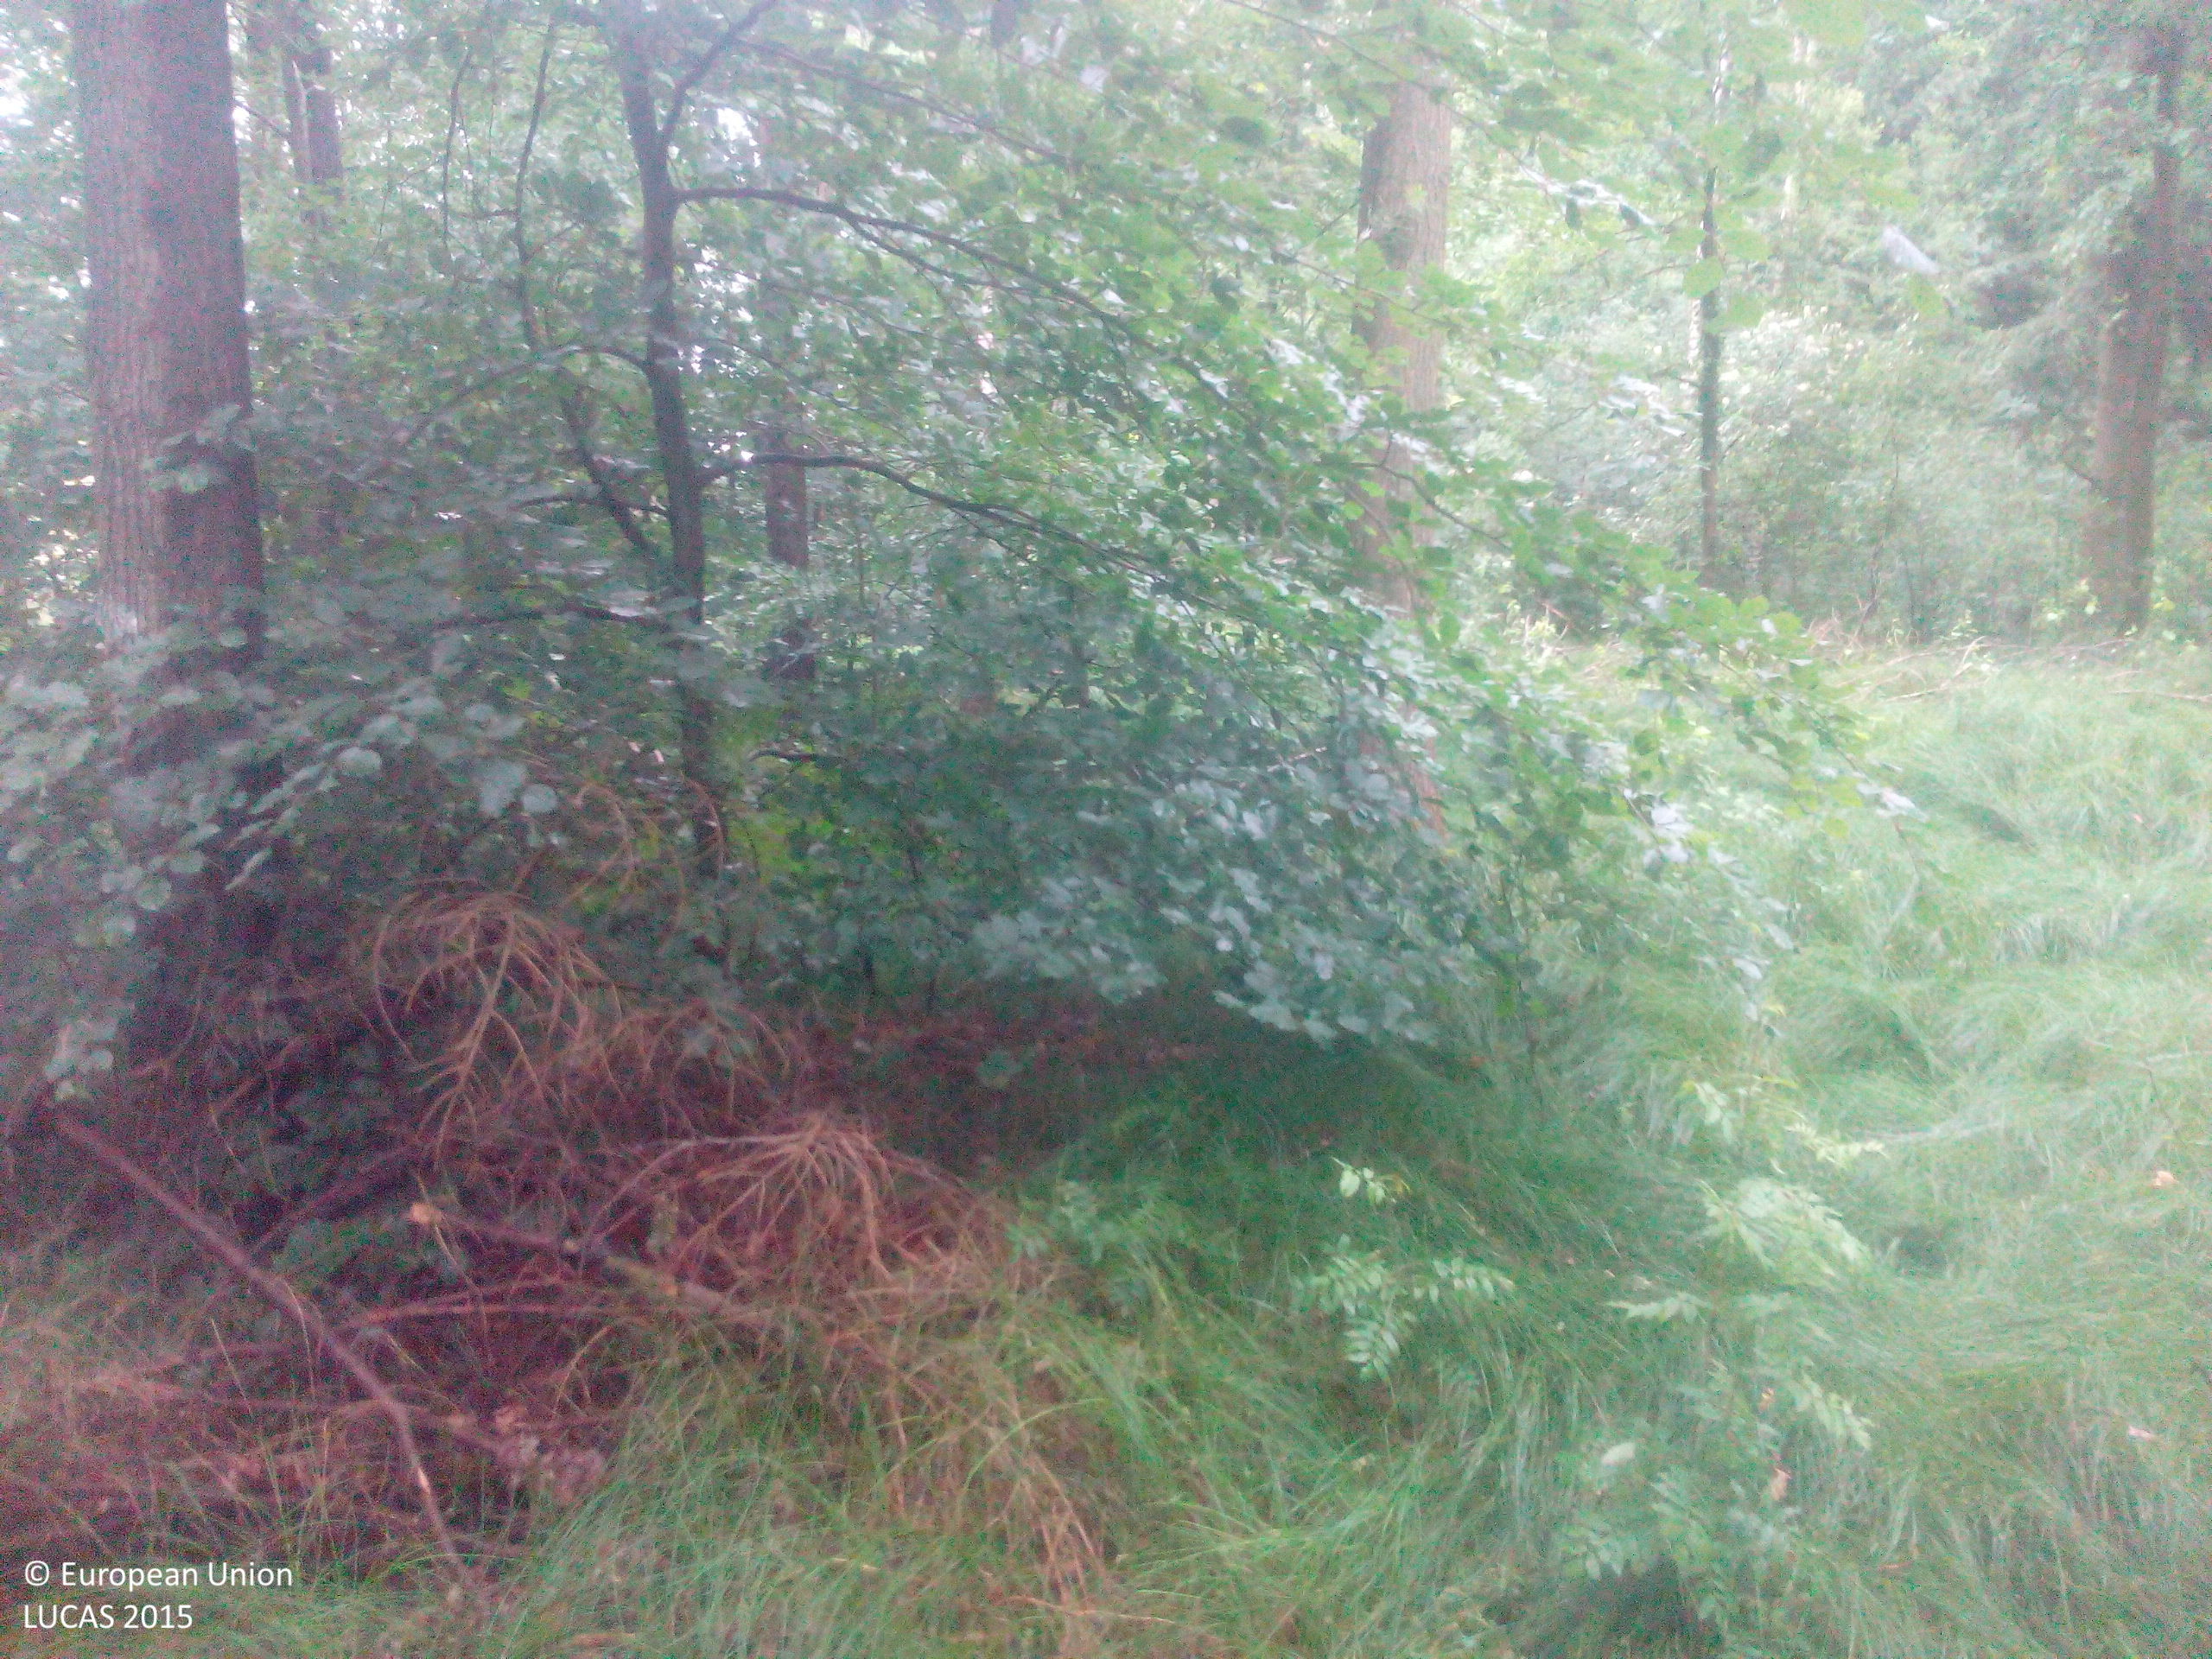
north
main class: Woodland
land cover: Spruce dominated mixed woodland
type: hemiboreal forest and nemoral coniferous forest and mixed broadleaved-coniferous forest
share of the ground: > 75 %
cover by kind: broadleaved forest trees 60 %, coniferous forest trees 25 %, herbaceous plants 15 %
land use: Forestry
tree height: > 5 m
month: June
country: DE
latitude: 51.0868
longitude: 13.9841
